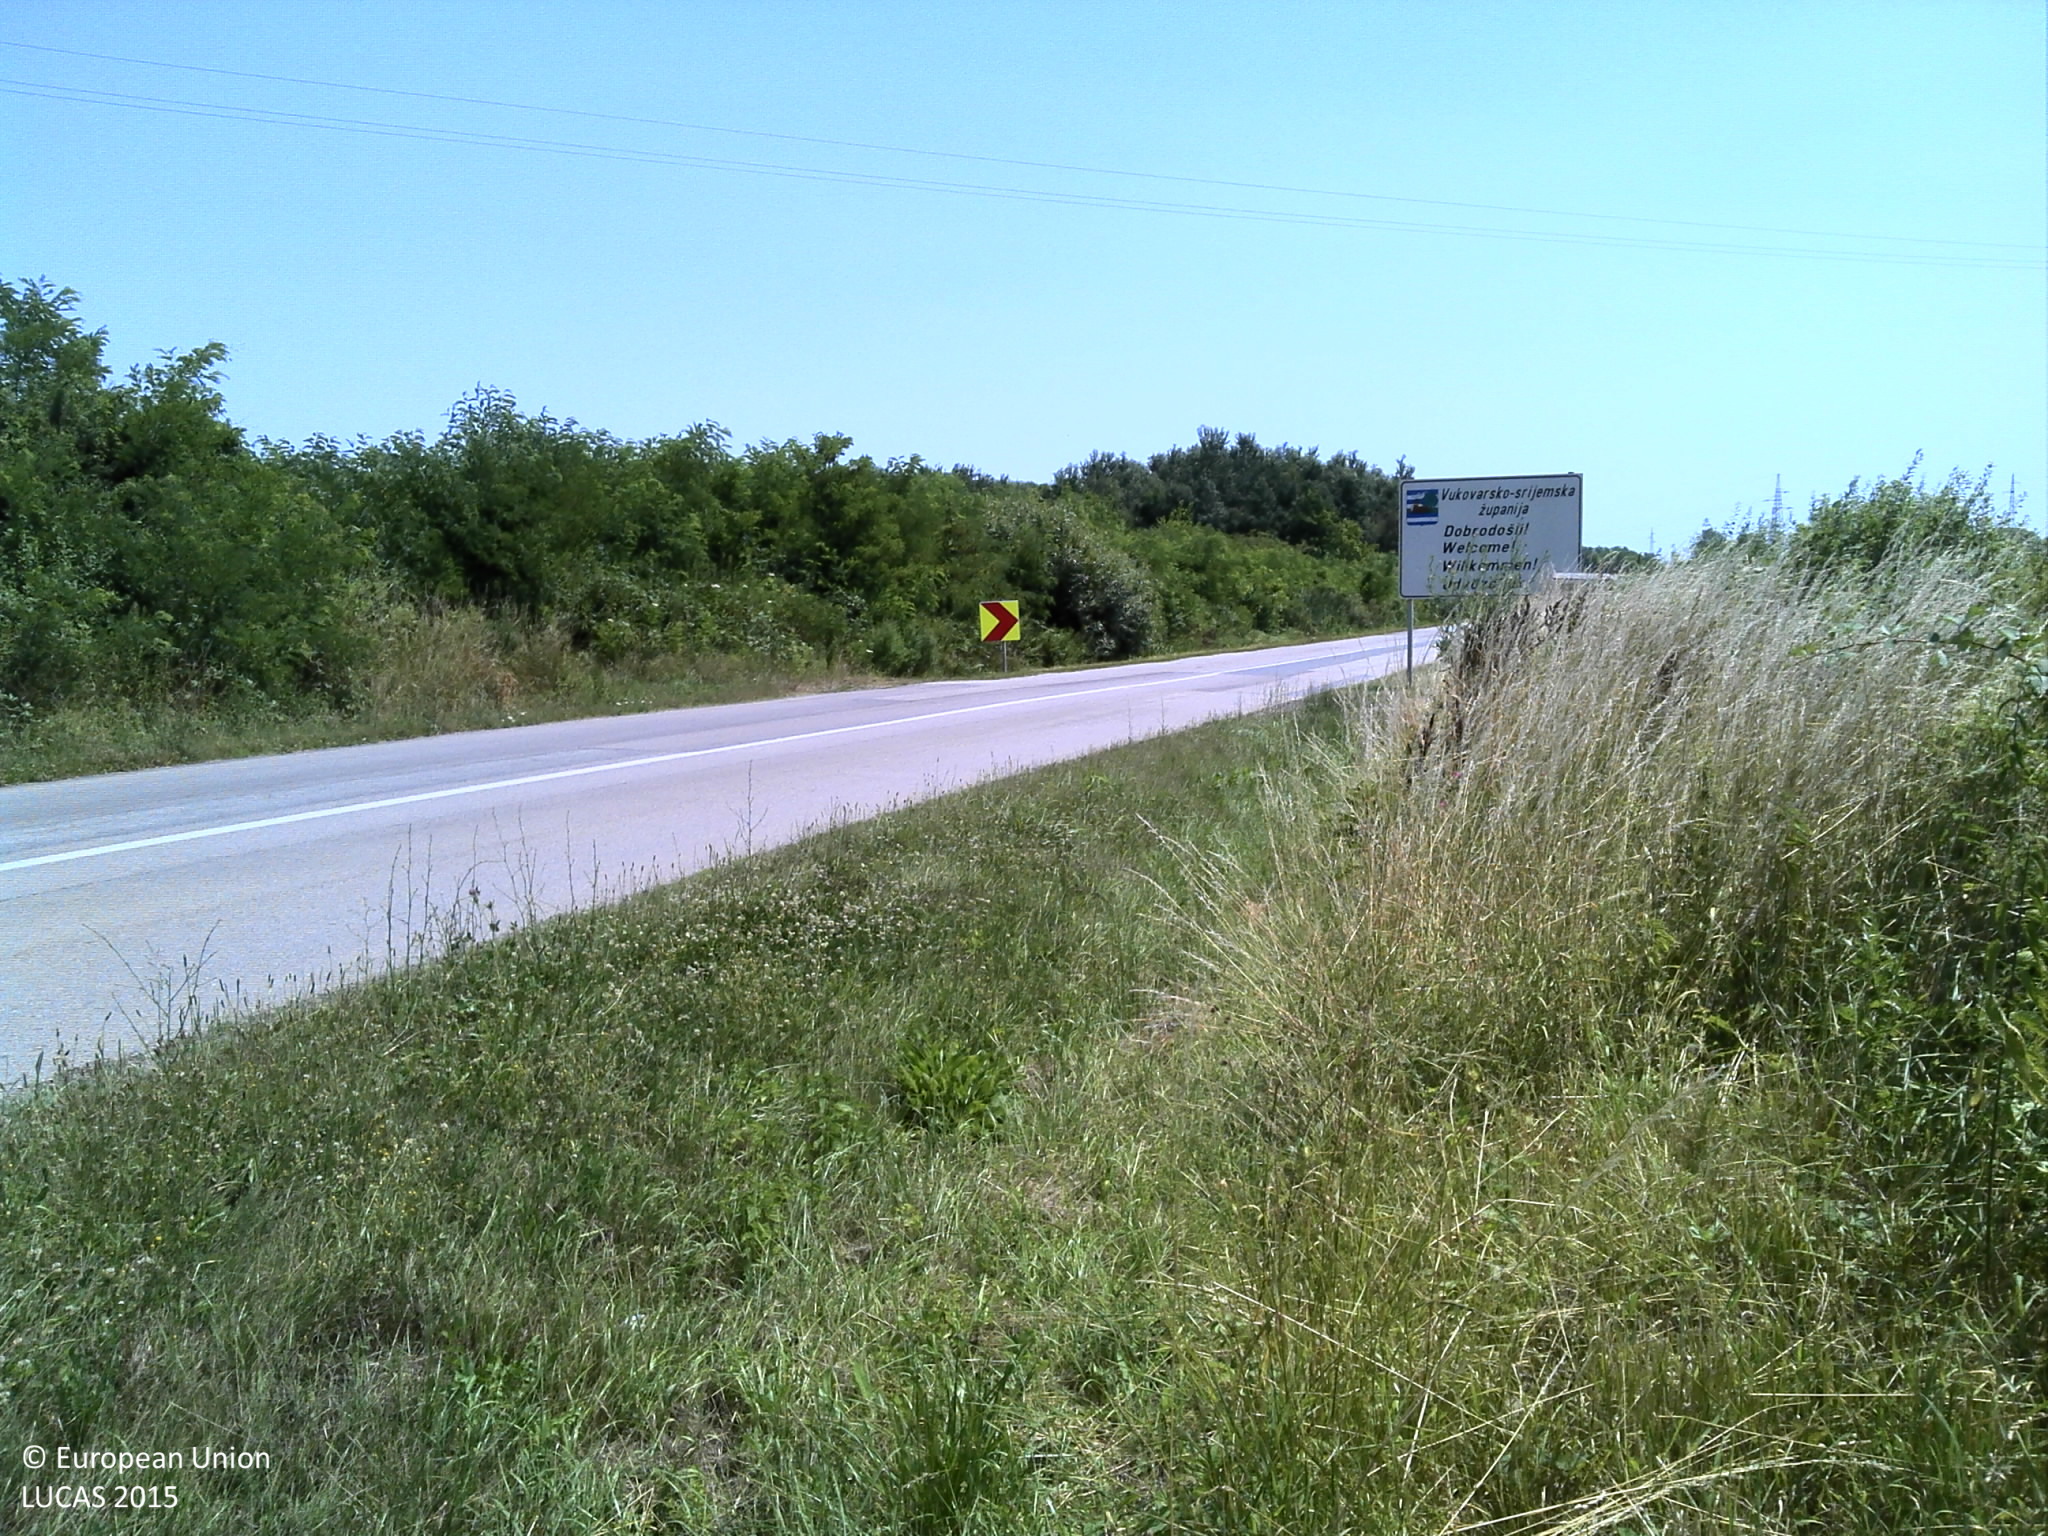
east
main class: Grassland
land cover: Grassland without tree/shrub cover
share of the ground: > 75 %
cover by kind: herbaceous plants 100 %
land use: Semi-natural and natural areas not in use
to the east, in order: Grassland without tree/shrub cover; Paved roads, cycling and walking lanes; Electric lines; Grass margins; Ditches and canals; Shrubland with sparse tree cover; Ditches and canals; Tracks; Ditches and canals; Broadleaved woodland
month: July
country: HR
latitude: 45.2872
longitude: 18.5096
